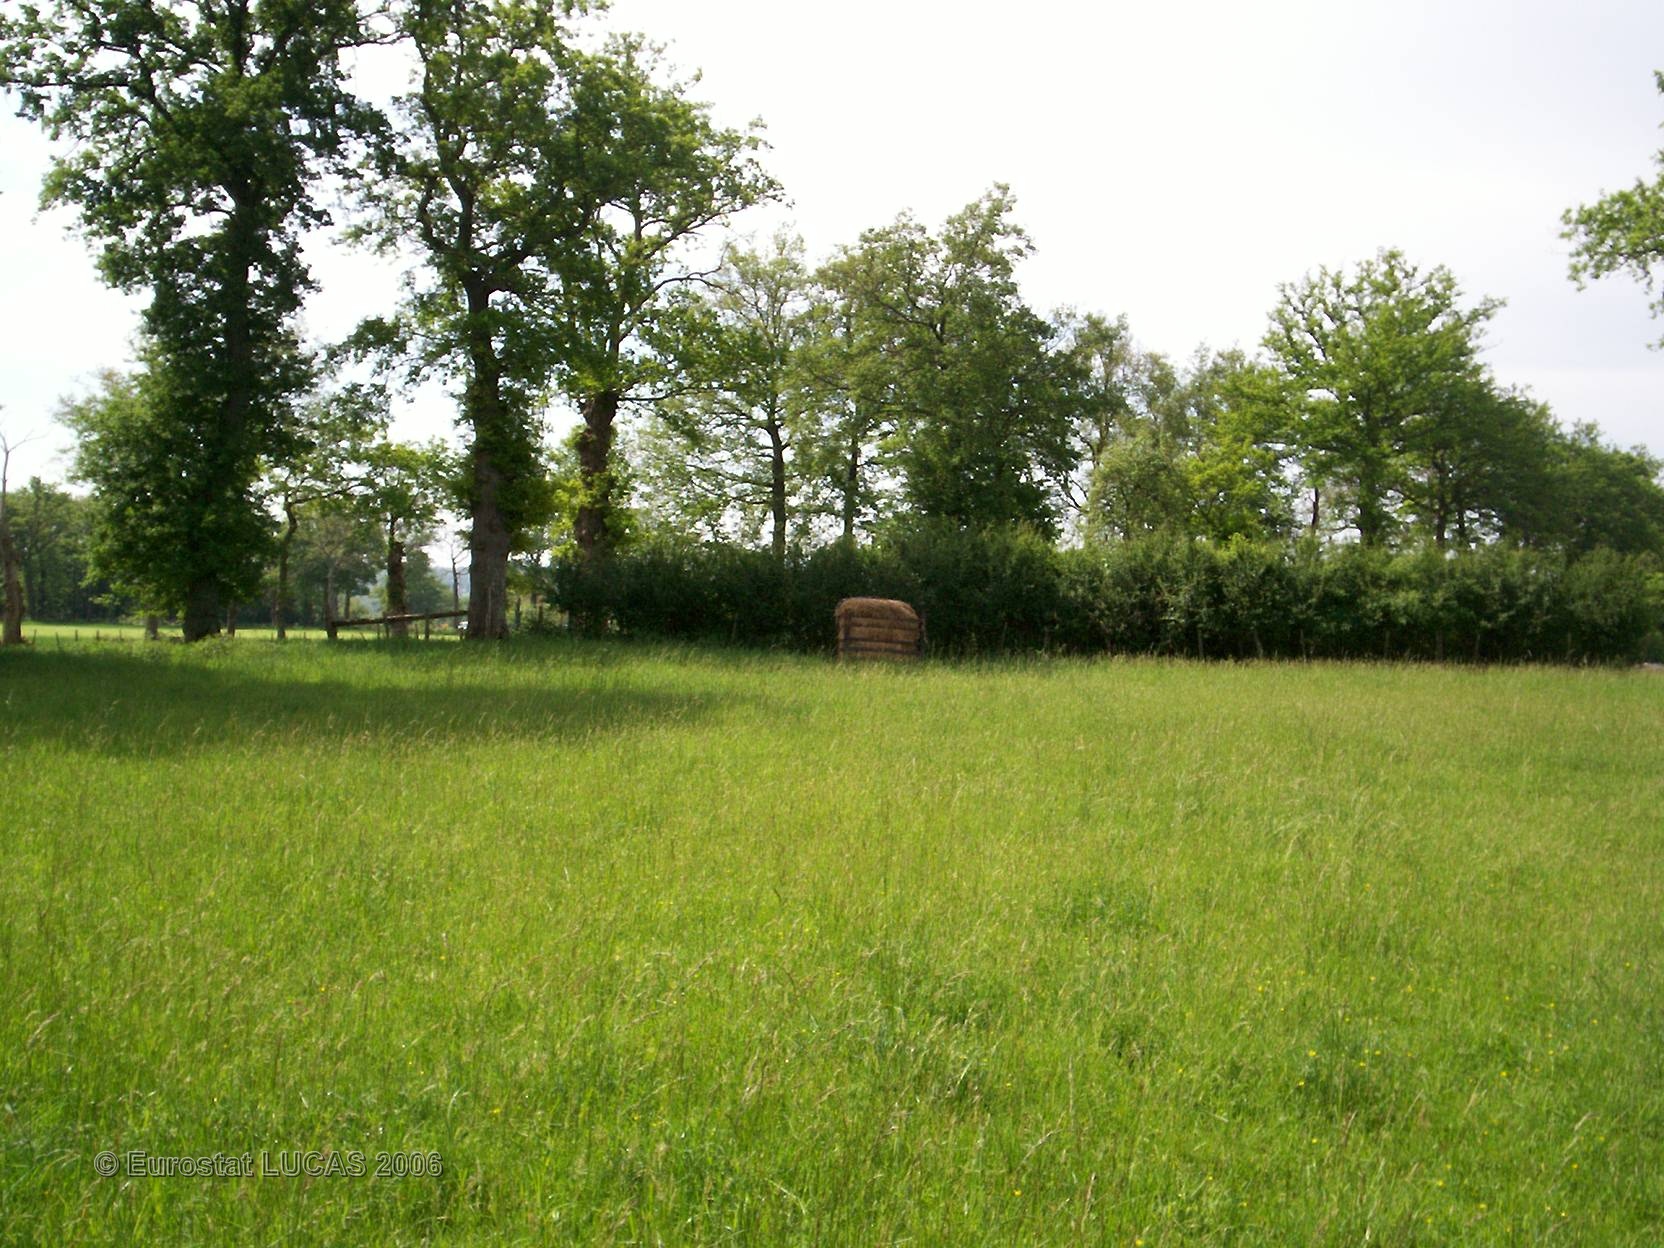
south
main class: Grassland
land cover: Grassland without tree/shrub cover
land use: Agriculture (excluding fallow land and kitchen gardens)
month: May
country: FR
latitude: 46.1736
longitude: 1.0374
